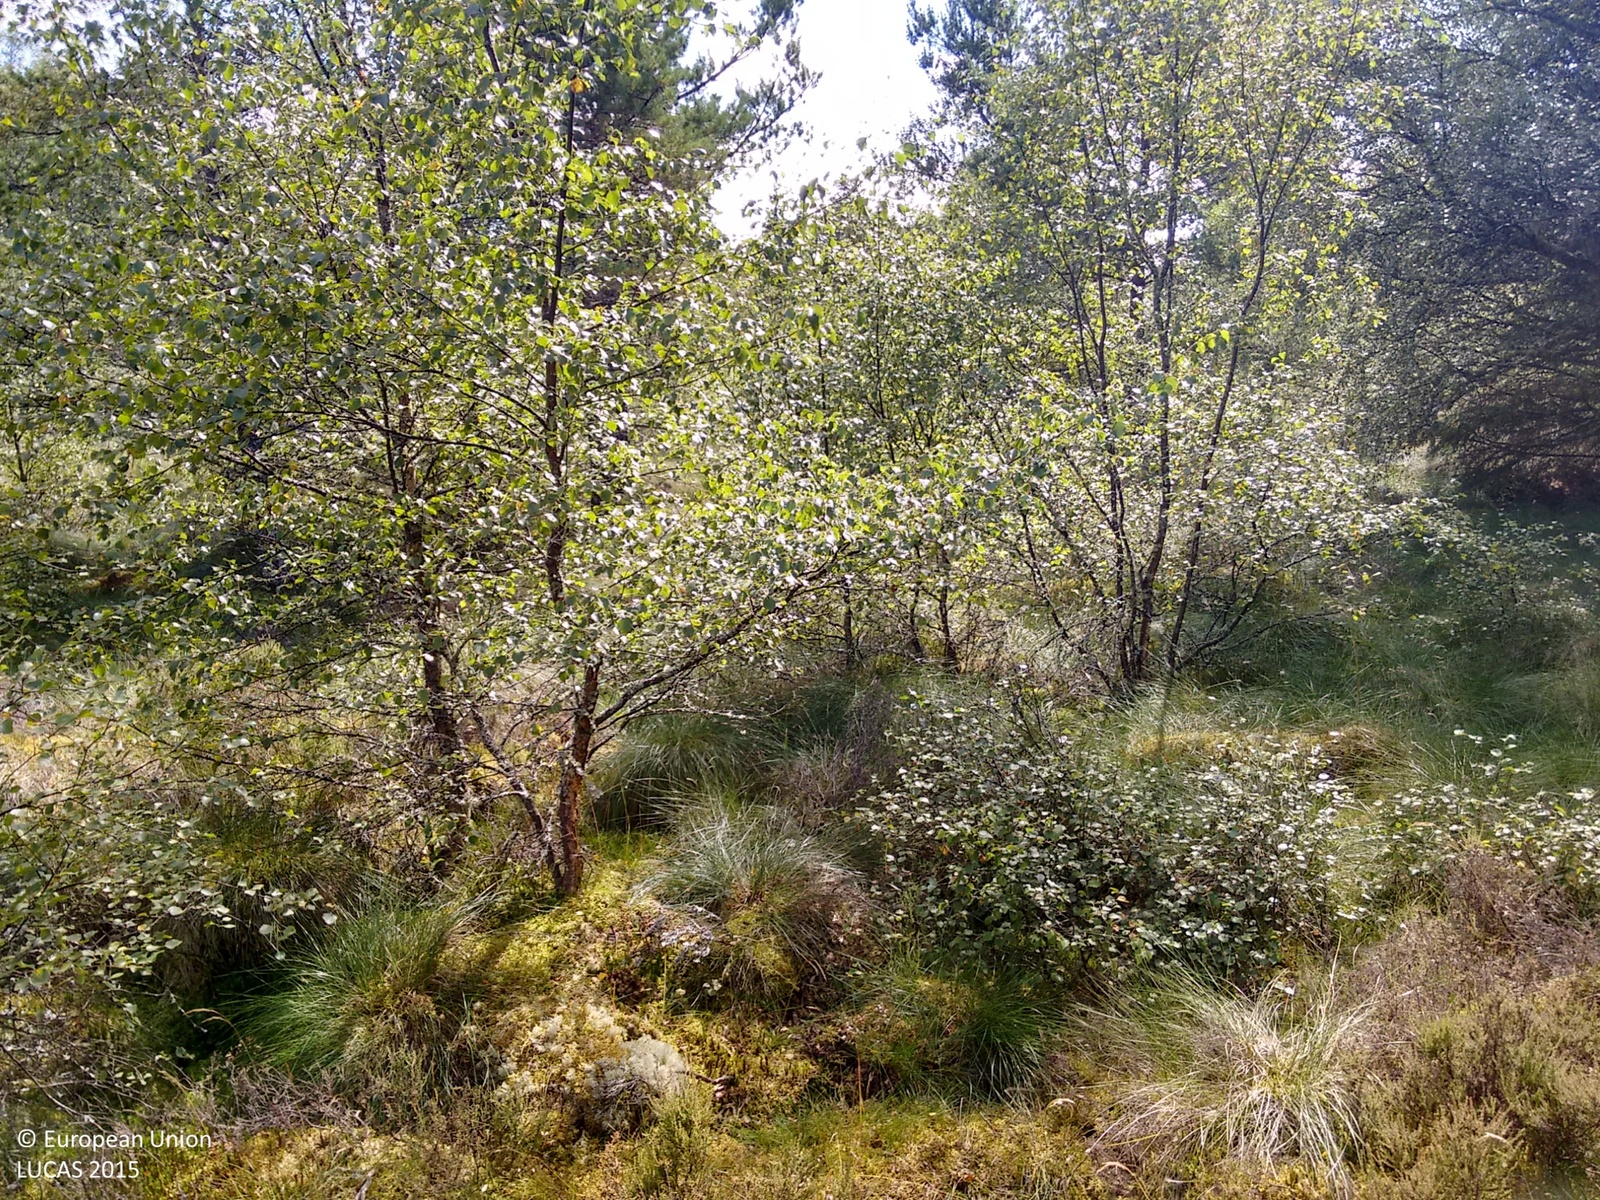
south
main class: Woodland
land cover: Other mixed woodland
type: exotic forest
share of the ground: > 75 %
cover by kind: broadleaved forest trees 55 %, coniferous forest trees 20 %, shrubs 10 %, herbaceous plants 10 %, lichens and mosses 5 %
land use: Forestry
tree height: > 5 m
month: August
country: GB
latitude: 57.5614
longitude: -3.0495
